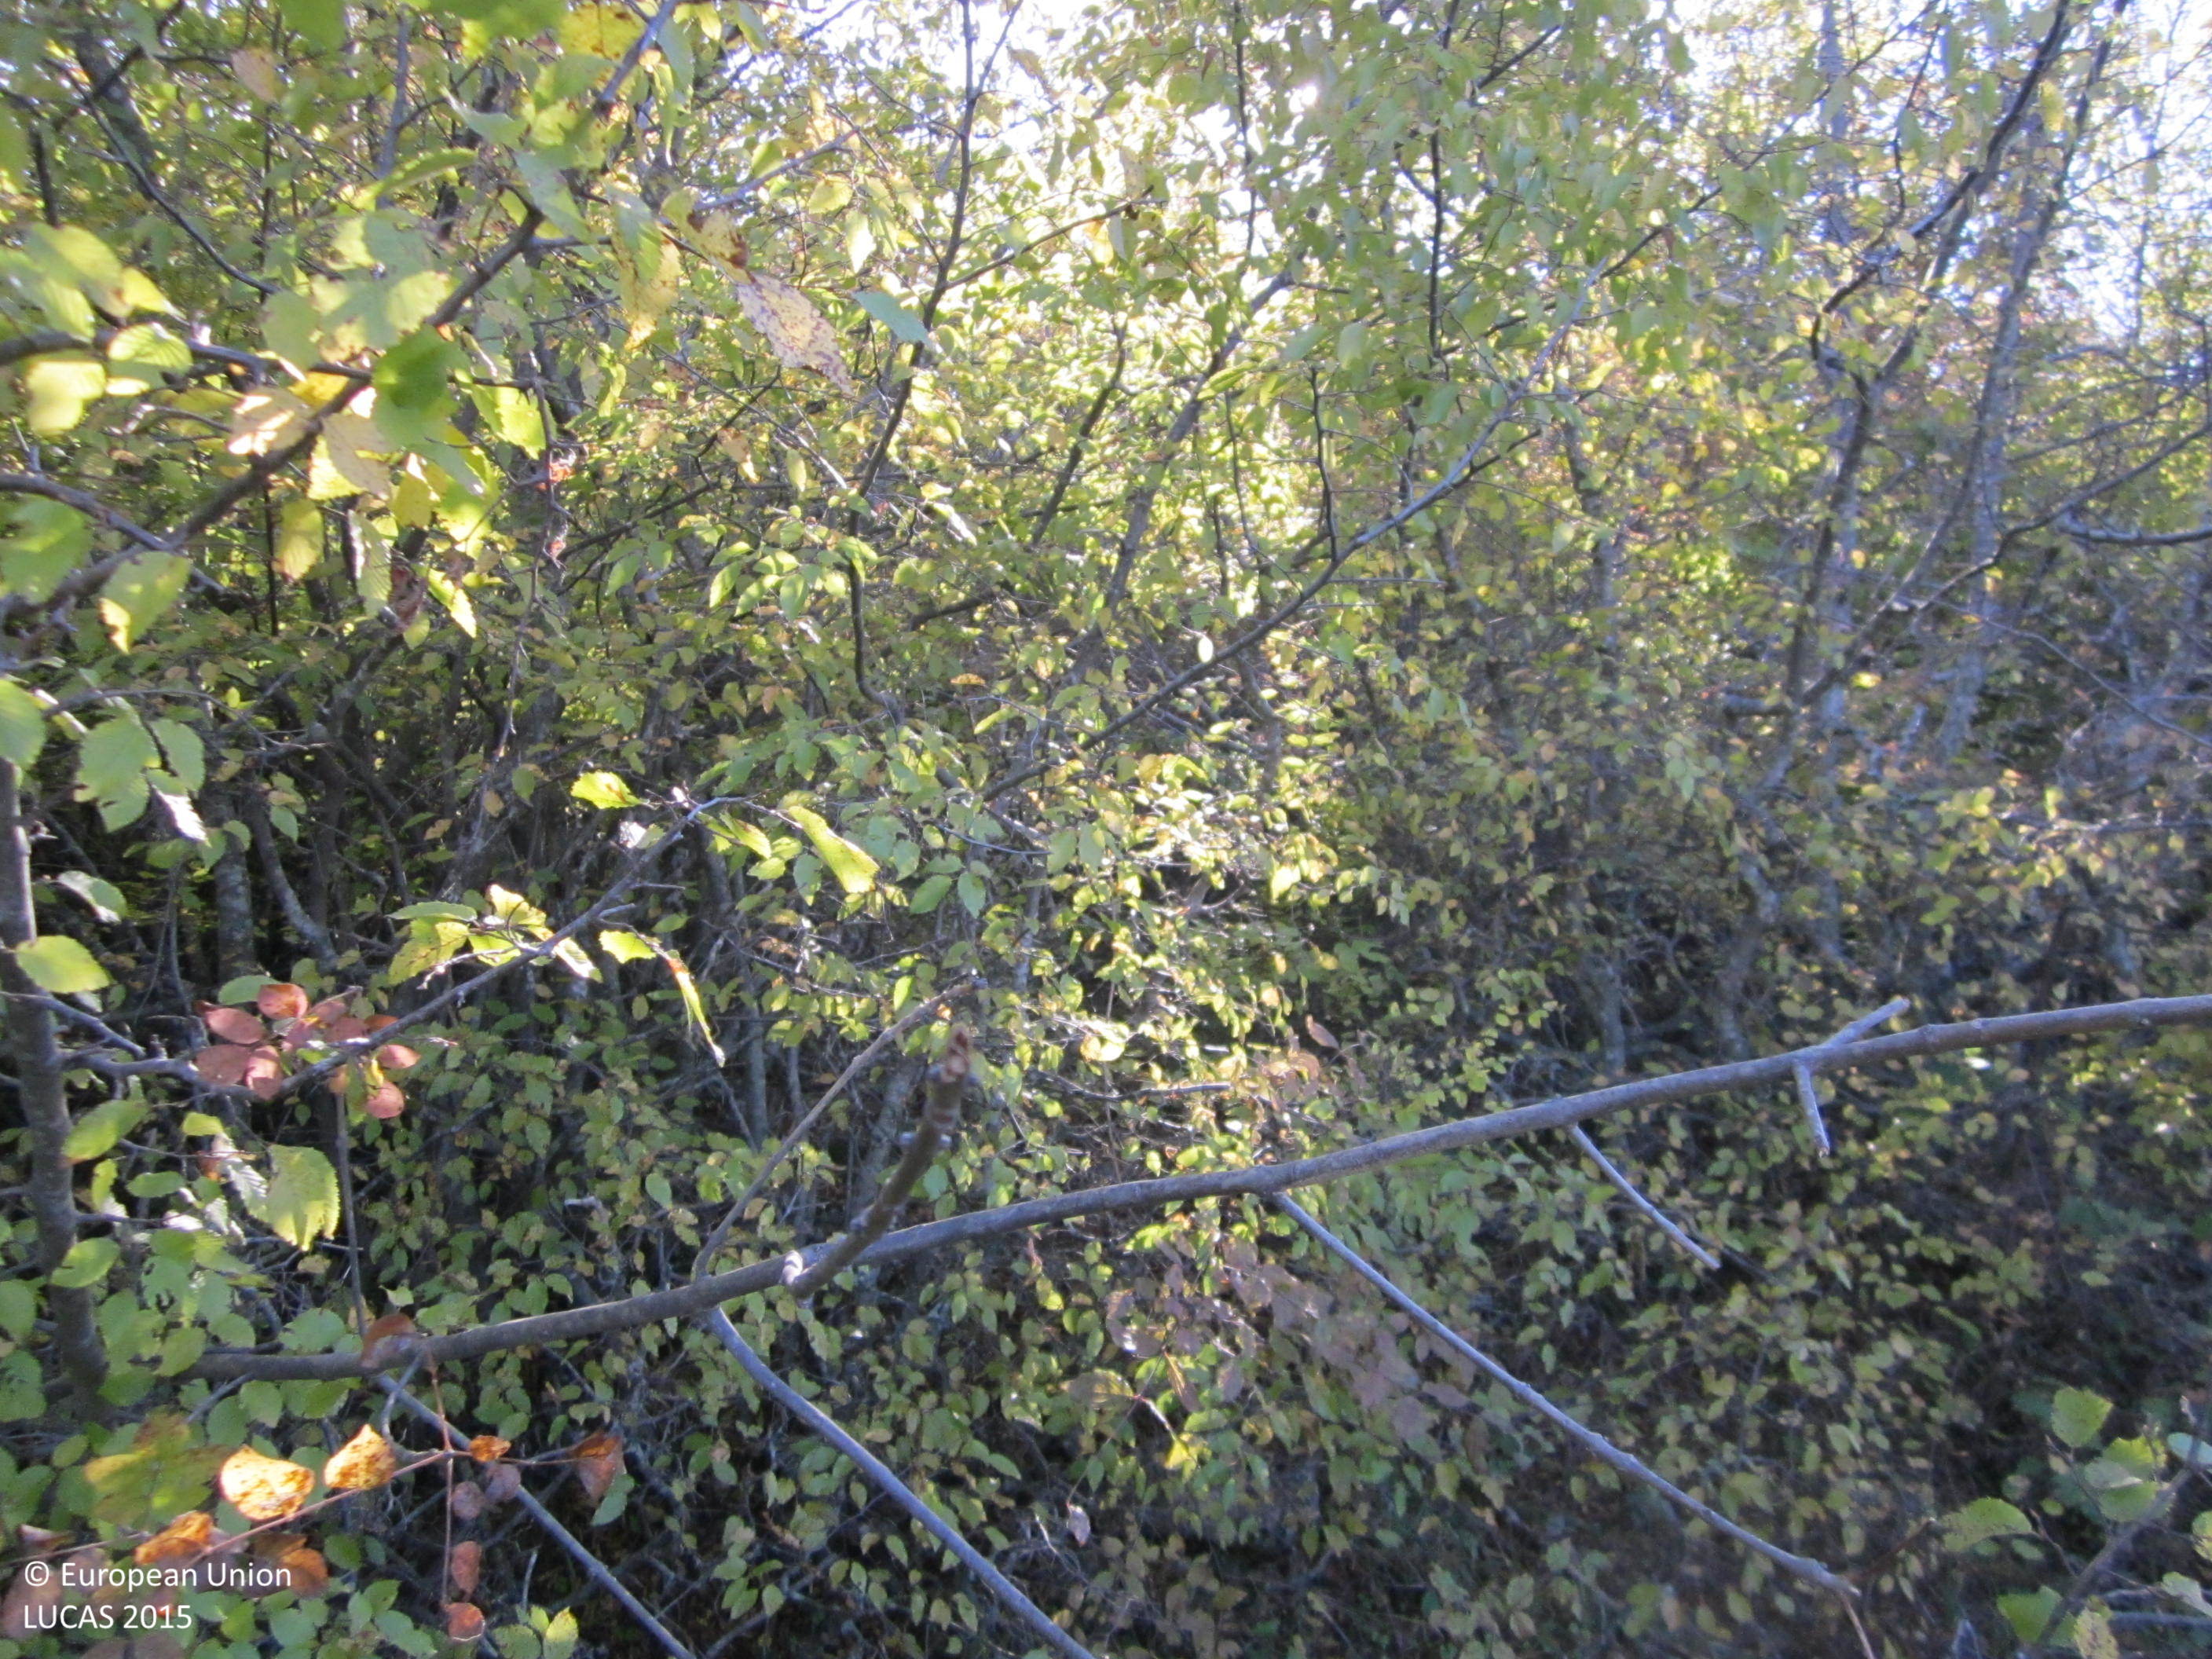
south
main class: Shrubland
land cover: Shrubland with sparse tree cover
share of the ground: > 75 %
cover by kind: shrubs 85 %, herbaceous plants 10 %, broadleaved forest trees 5 %
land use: Semi-natural and natural areas not in use
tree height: < 5 m
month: October
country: BG
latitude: 41.4257
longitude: 25.5533
